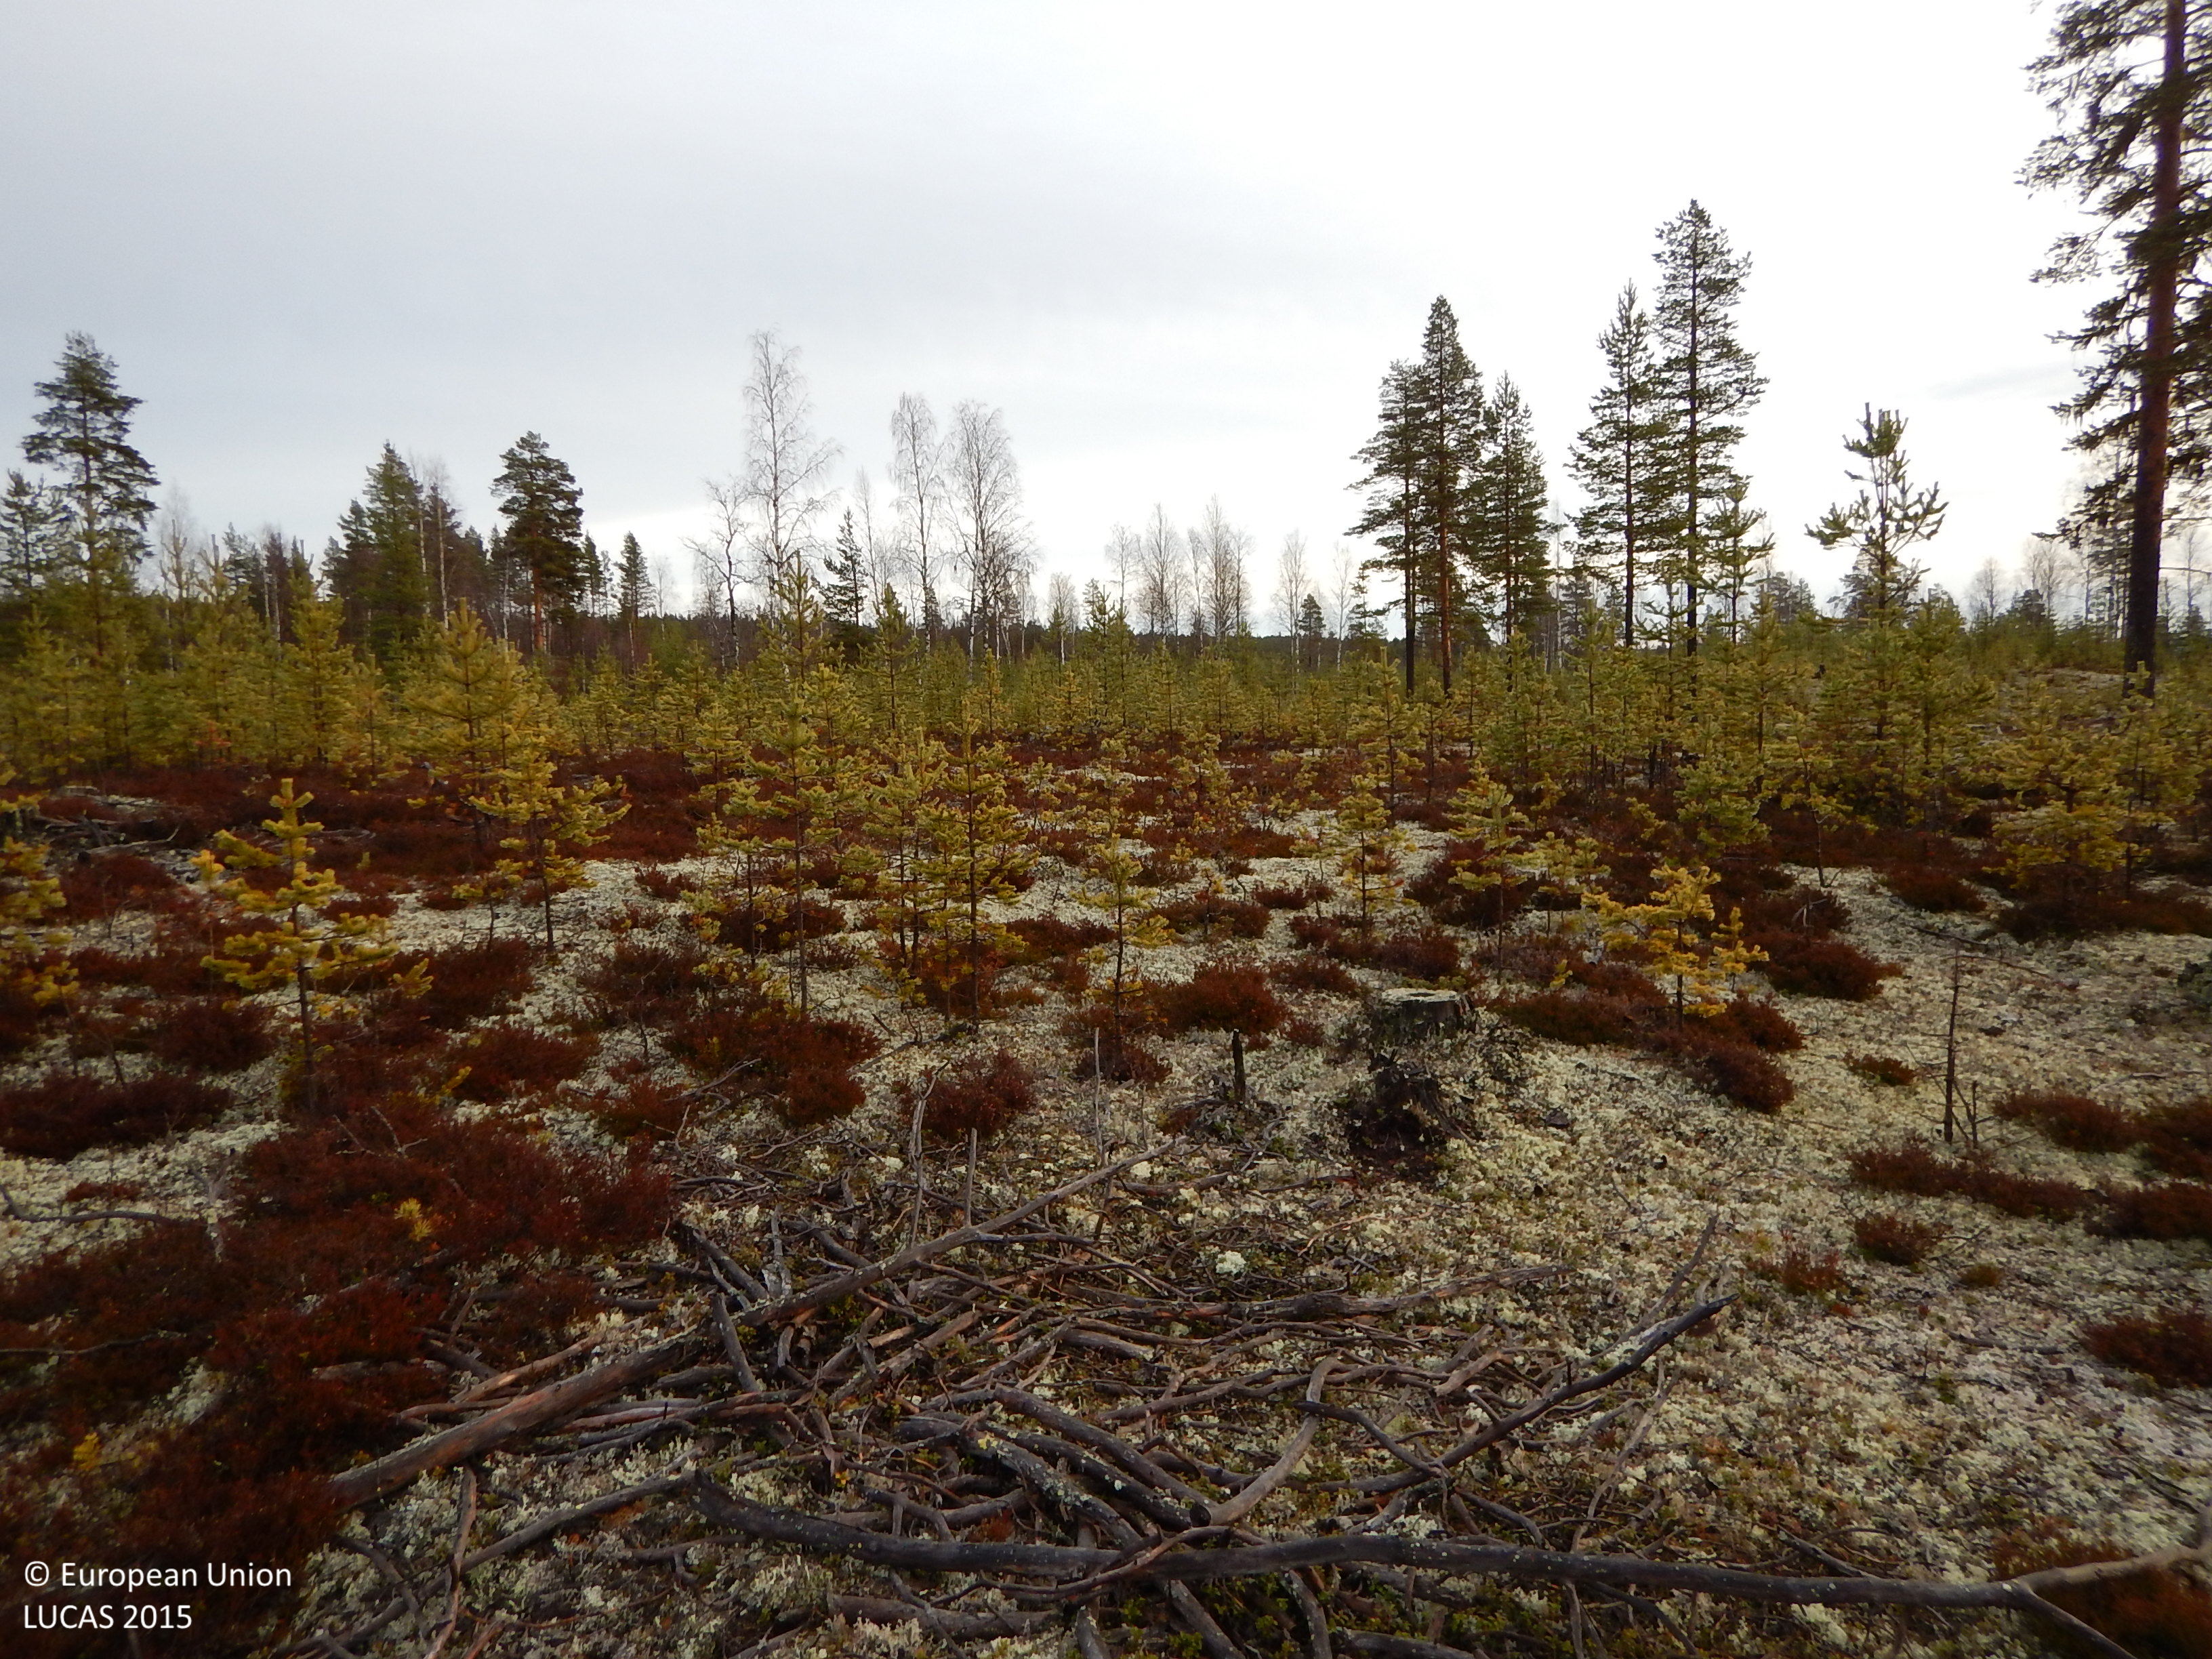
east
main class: Woodland
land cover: Pine dominated coniferous woodland
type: boreal forest
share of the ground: 25 - 50 %
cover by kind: lichens and mosses 40 %, coniferous forest trees 35 %, shrubs 20 %, herbaceous plants 5 %
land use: Forestry
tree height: < 5 m
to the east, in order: Pine dominated coniferous woodland; Paved roads, cycling and walking lanes; Pine dominated mixed woodland; Broadleaved woodland
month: November
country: SE
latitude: 65.1716
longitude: 20.3640
